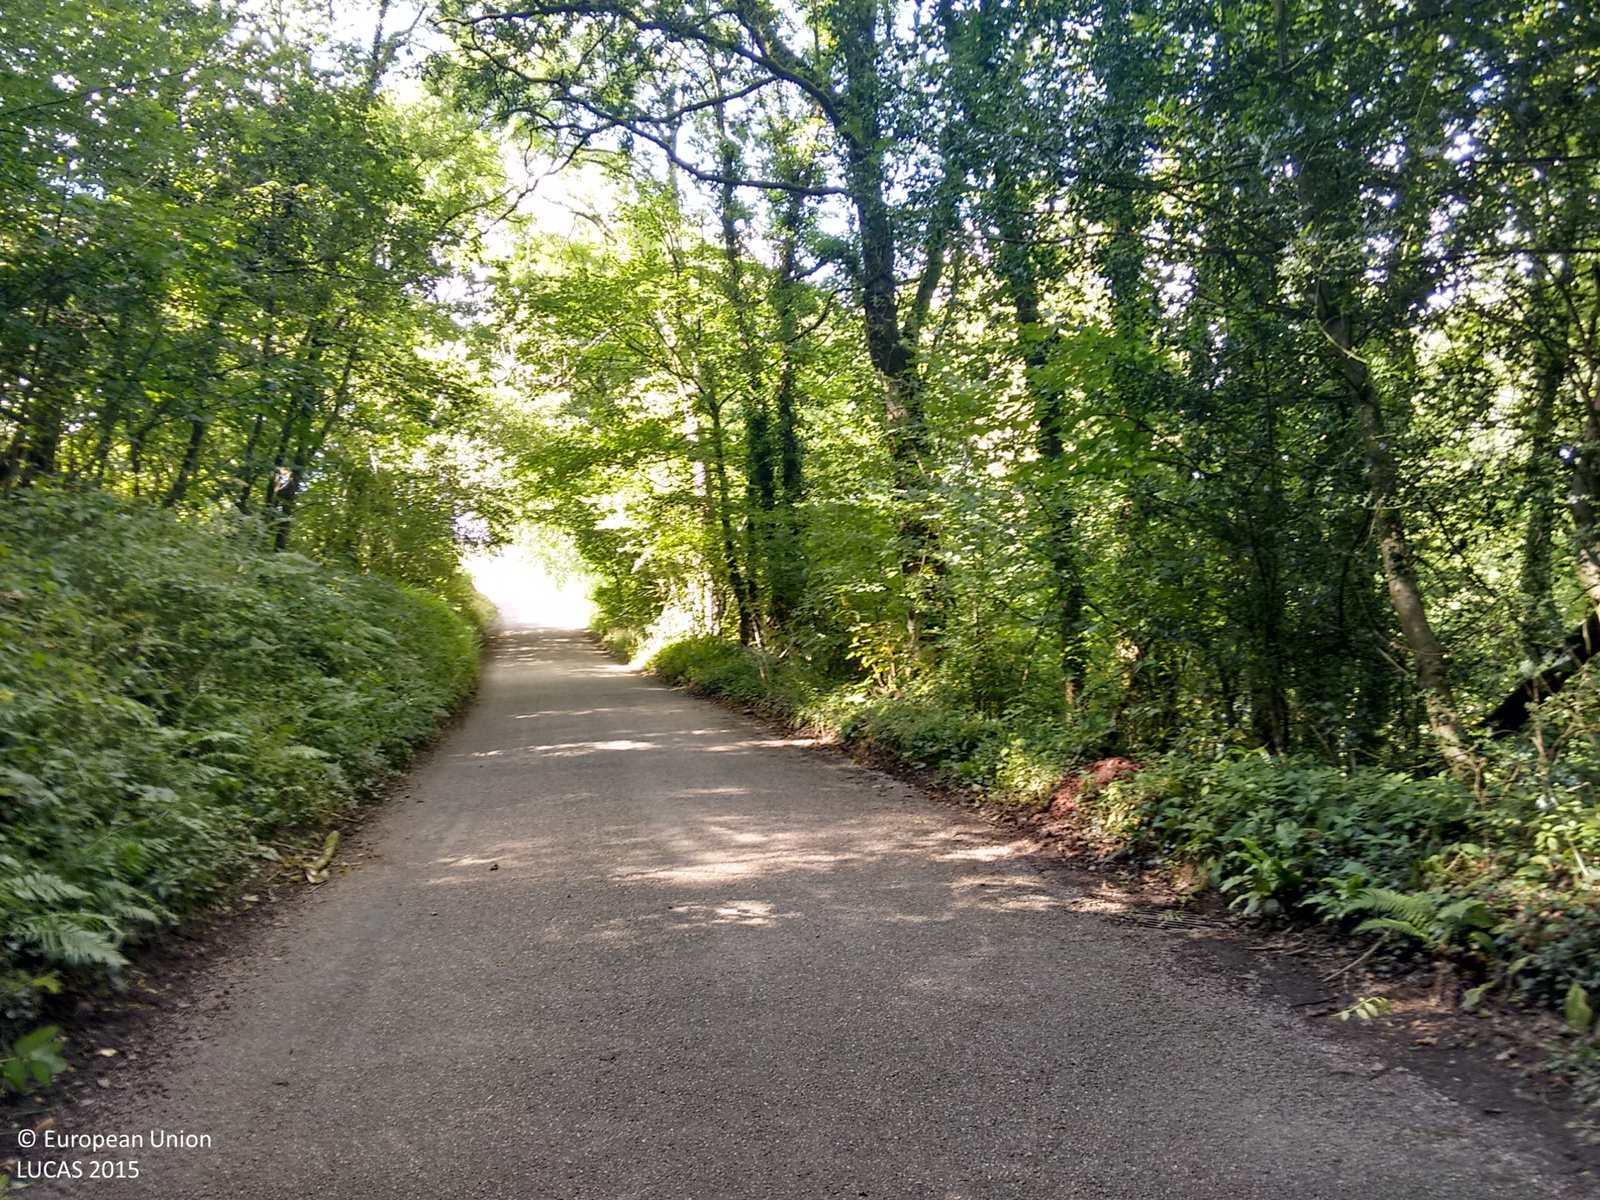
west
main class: Woodland
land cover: Broadleaved woodland
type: beech forest
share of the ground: > 75 %
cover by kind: broadleaved forest trees 100 %
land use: Semi-natural and natural areas not in use
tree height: > 5 m
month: September
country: GB
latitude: 50.9502
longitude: -3.9141
